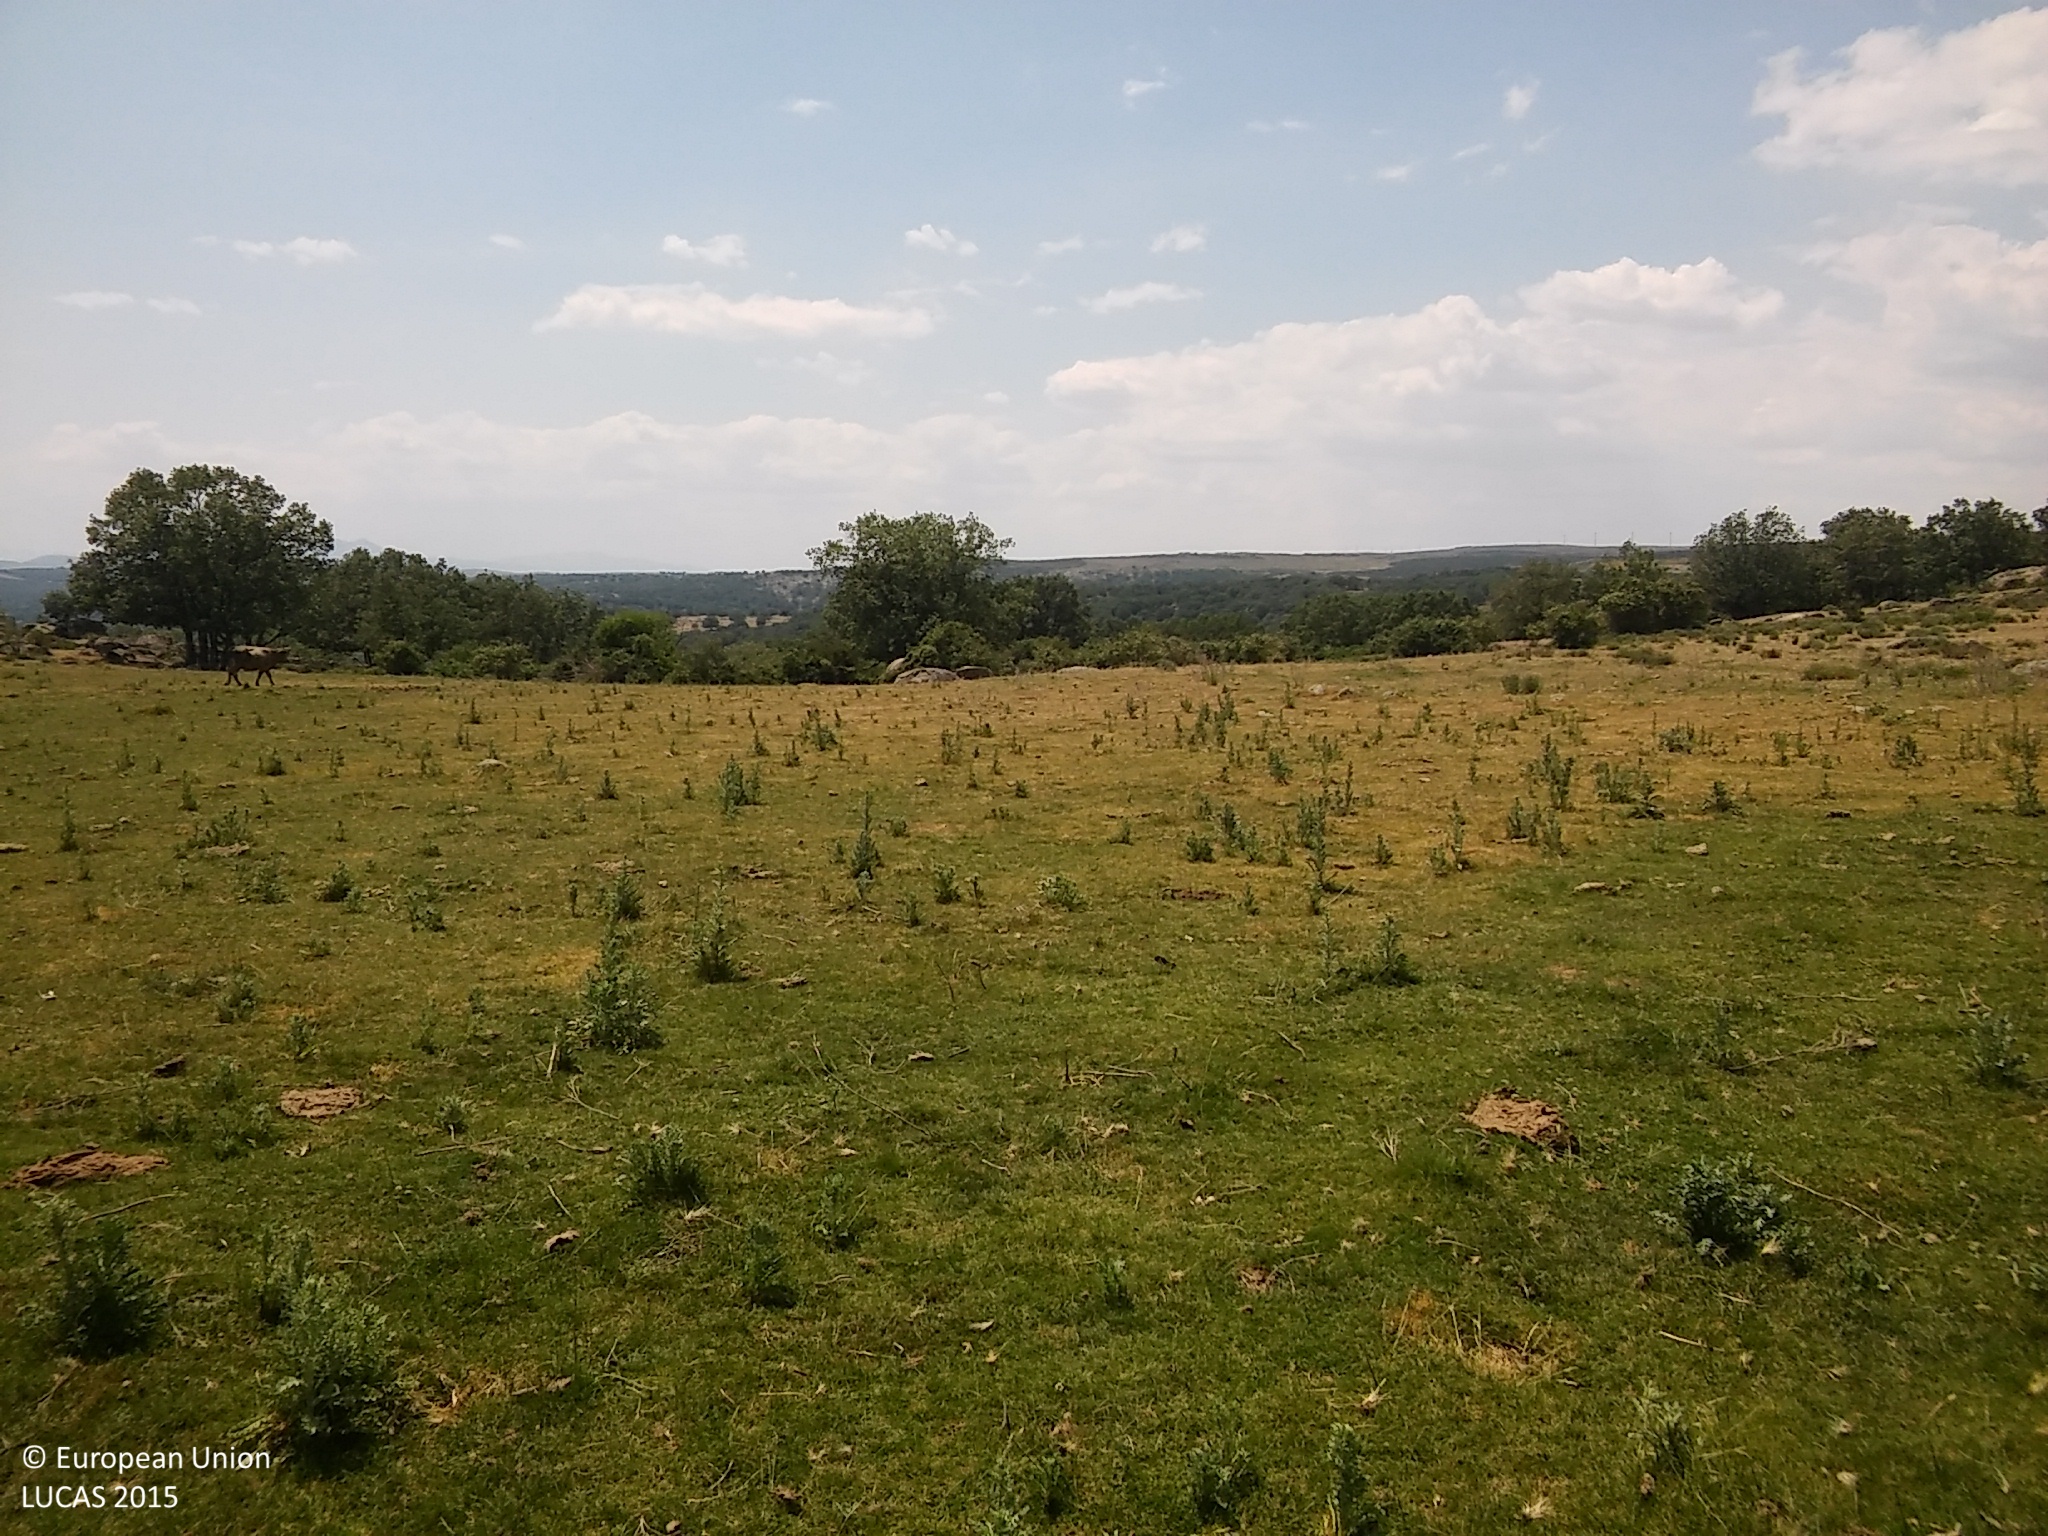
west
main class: Grassland
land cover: Grassland without tree/shrub cover
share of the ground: > 75 %
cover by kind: herbaceous plants 100 %
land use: Agriculture (excluding fallow land and kitchen gardens)
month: June
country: ES
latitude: 40.6095
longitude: -4.4104
